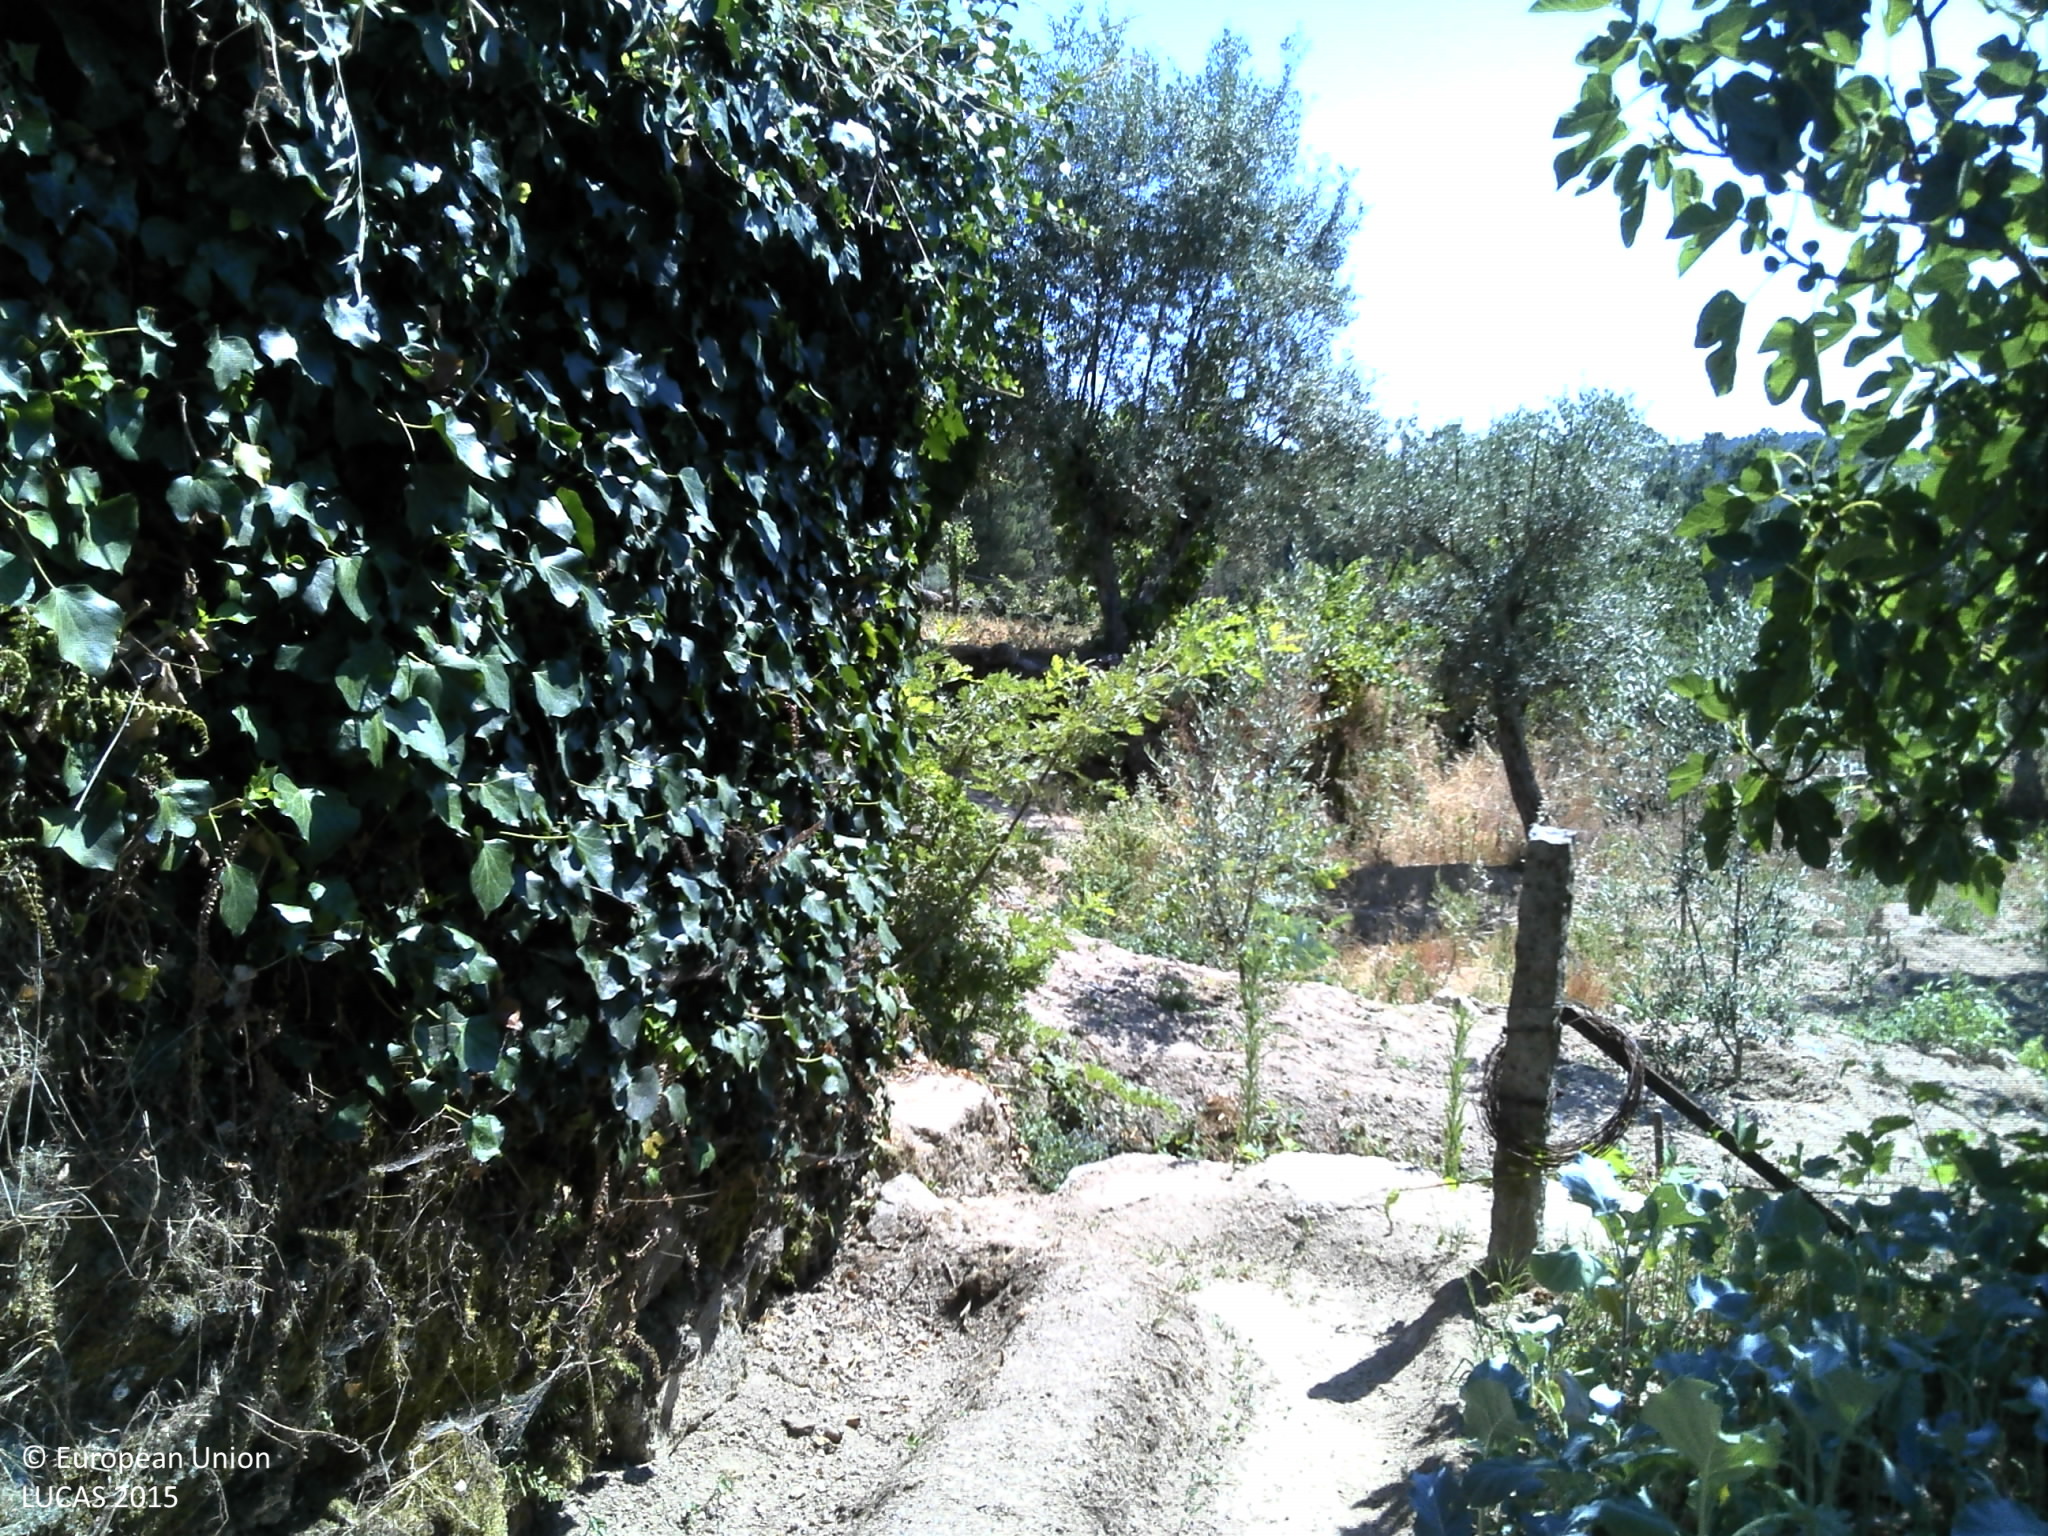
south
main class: Cropland
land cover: Olive groves
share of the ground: 10 - 25 %
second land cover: Other fresh vegetables
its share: 25 - 50 %
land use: Agriculture (excluding fallow land and kitchen gardens)
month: July
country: PT
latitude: 40.7369
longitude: -7.5590
